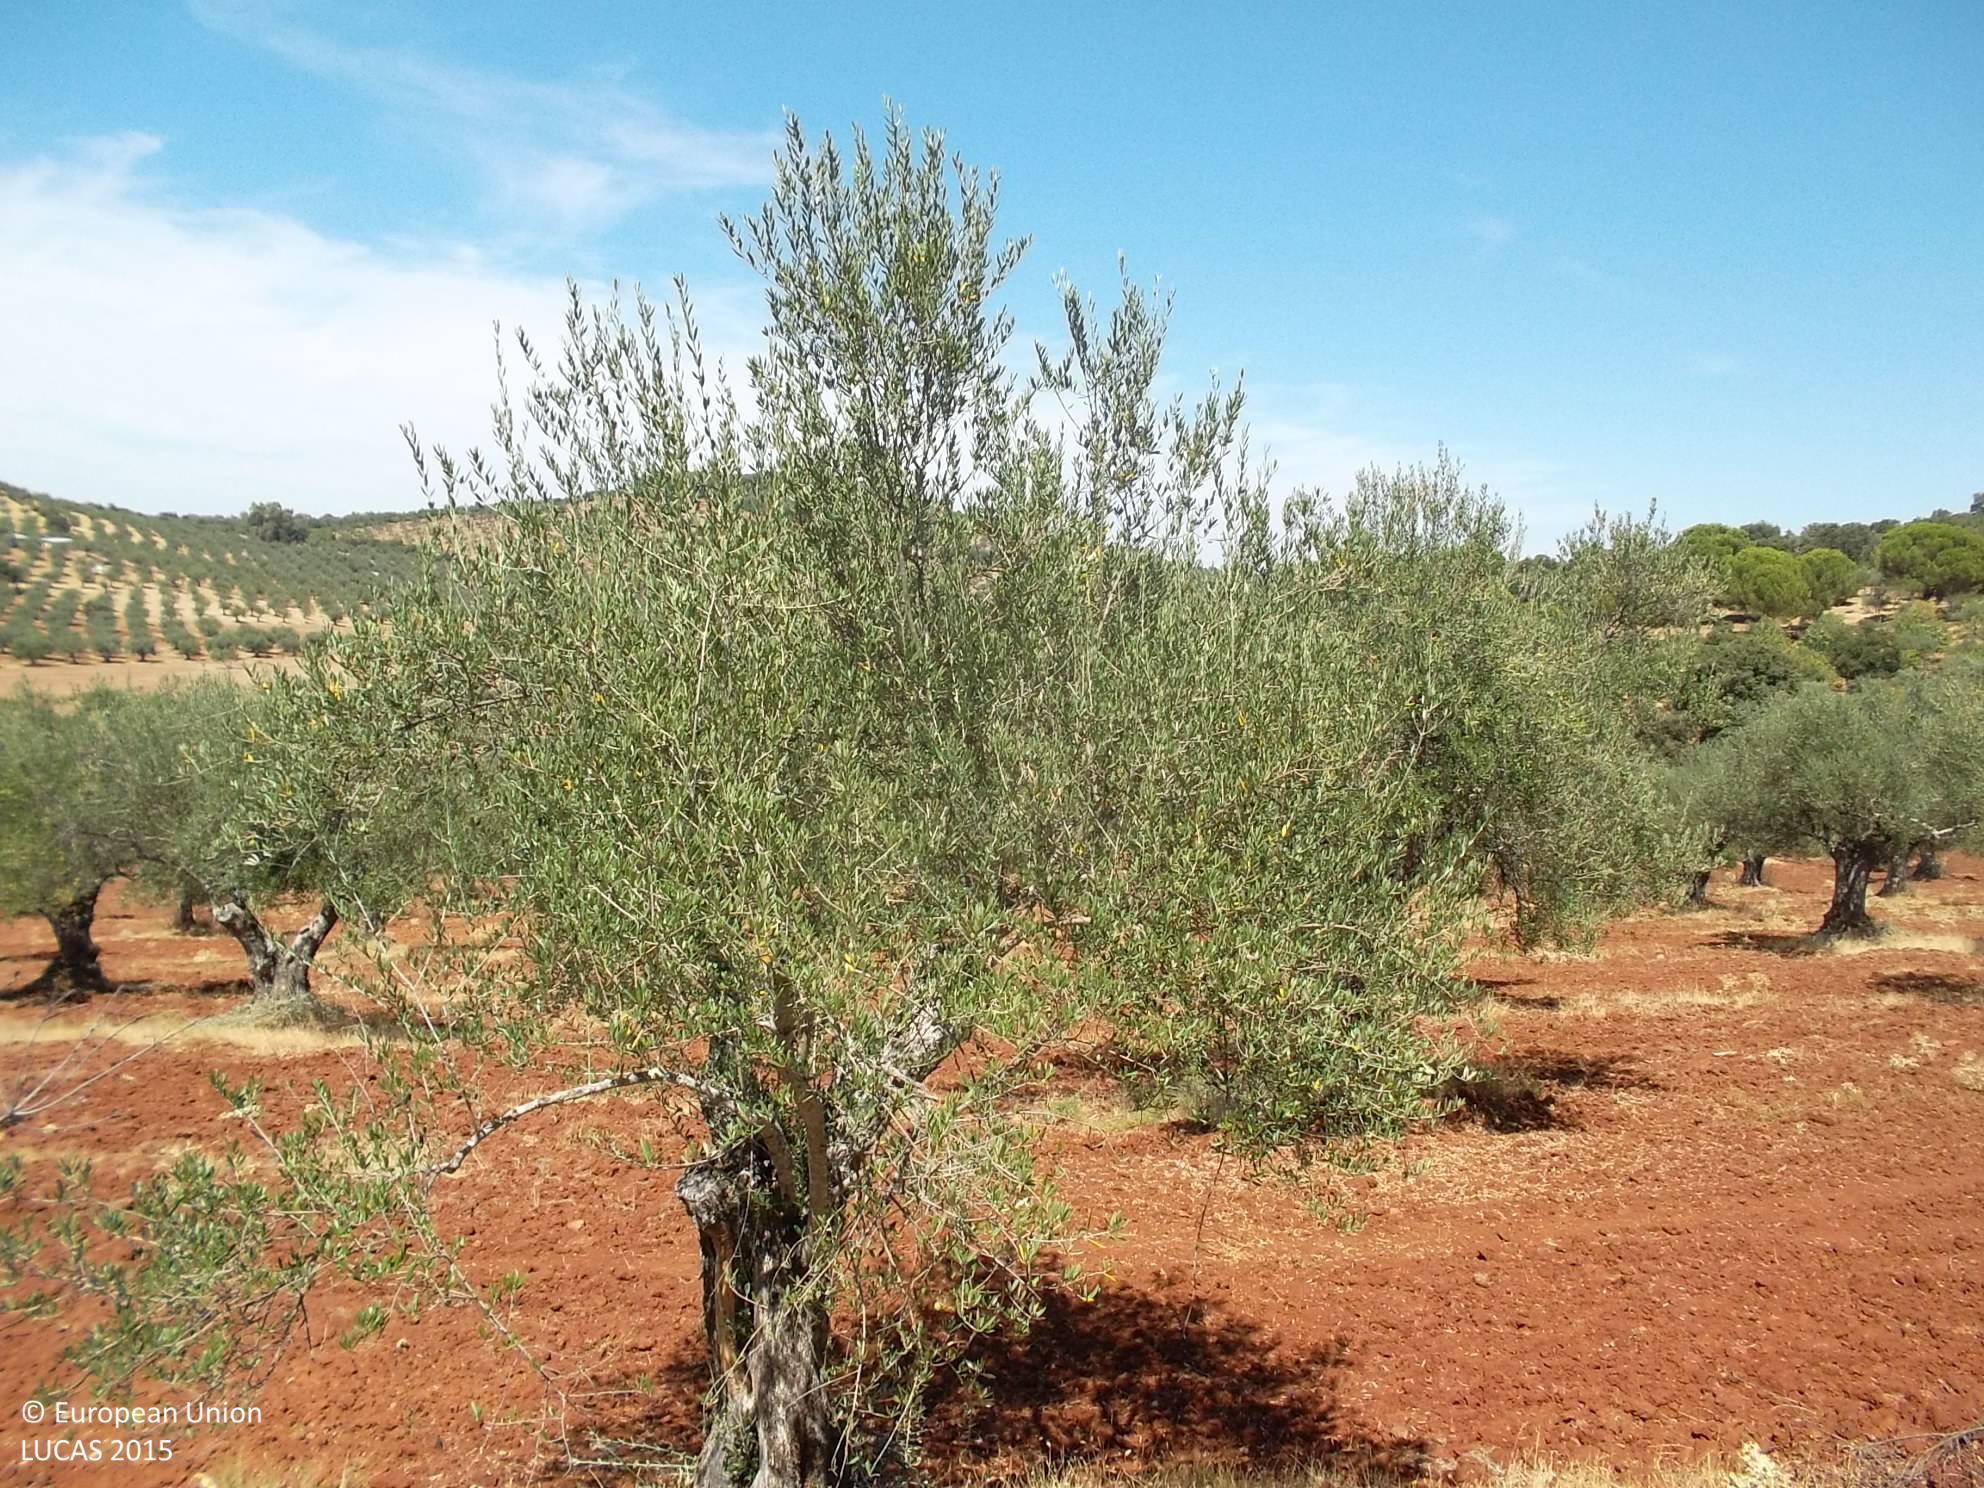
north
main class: Cropland
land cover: Olive groves
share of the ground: 10 - 25 %
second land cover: Other bare soil
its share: > 75 %
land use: Agriculture (excluding fallow land and kitchen gardens)
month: August
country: ES
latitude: 38.1603
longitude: -6.7025
